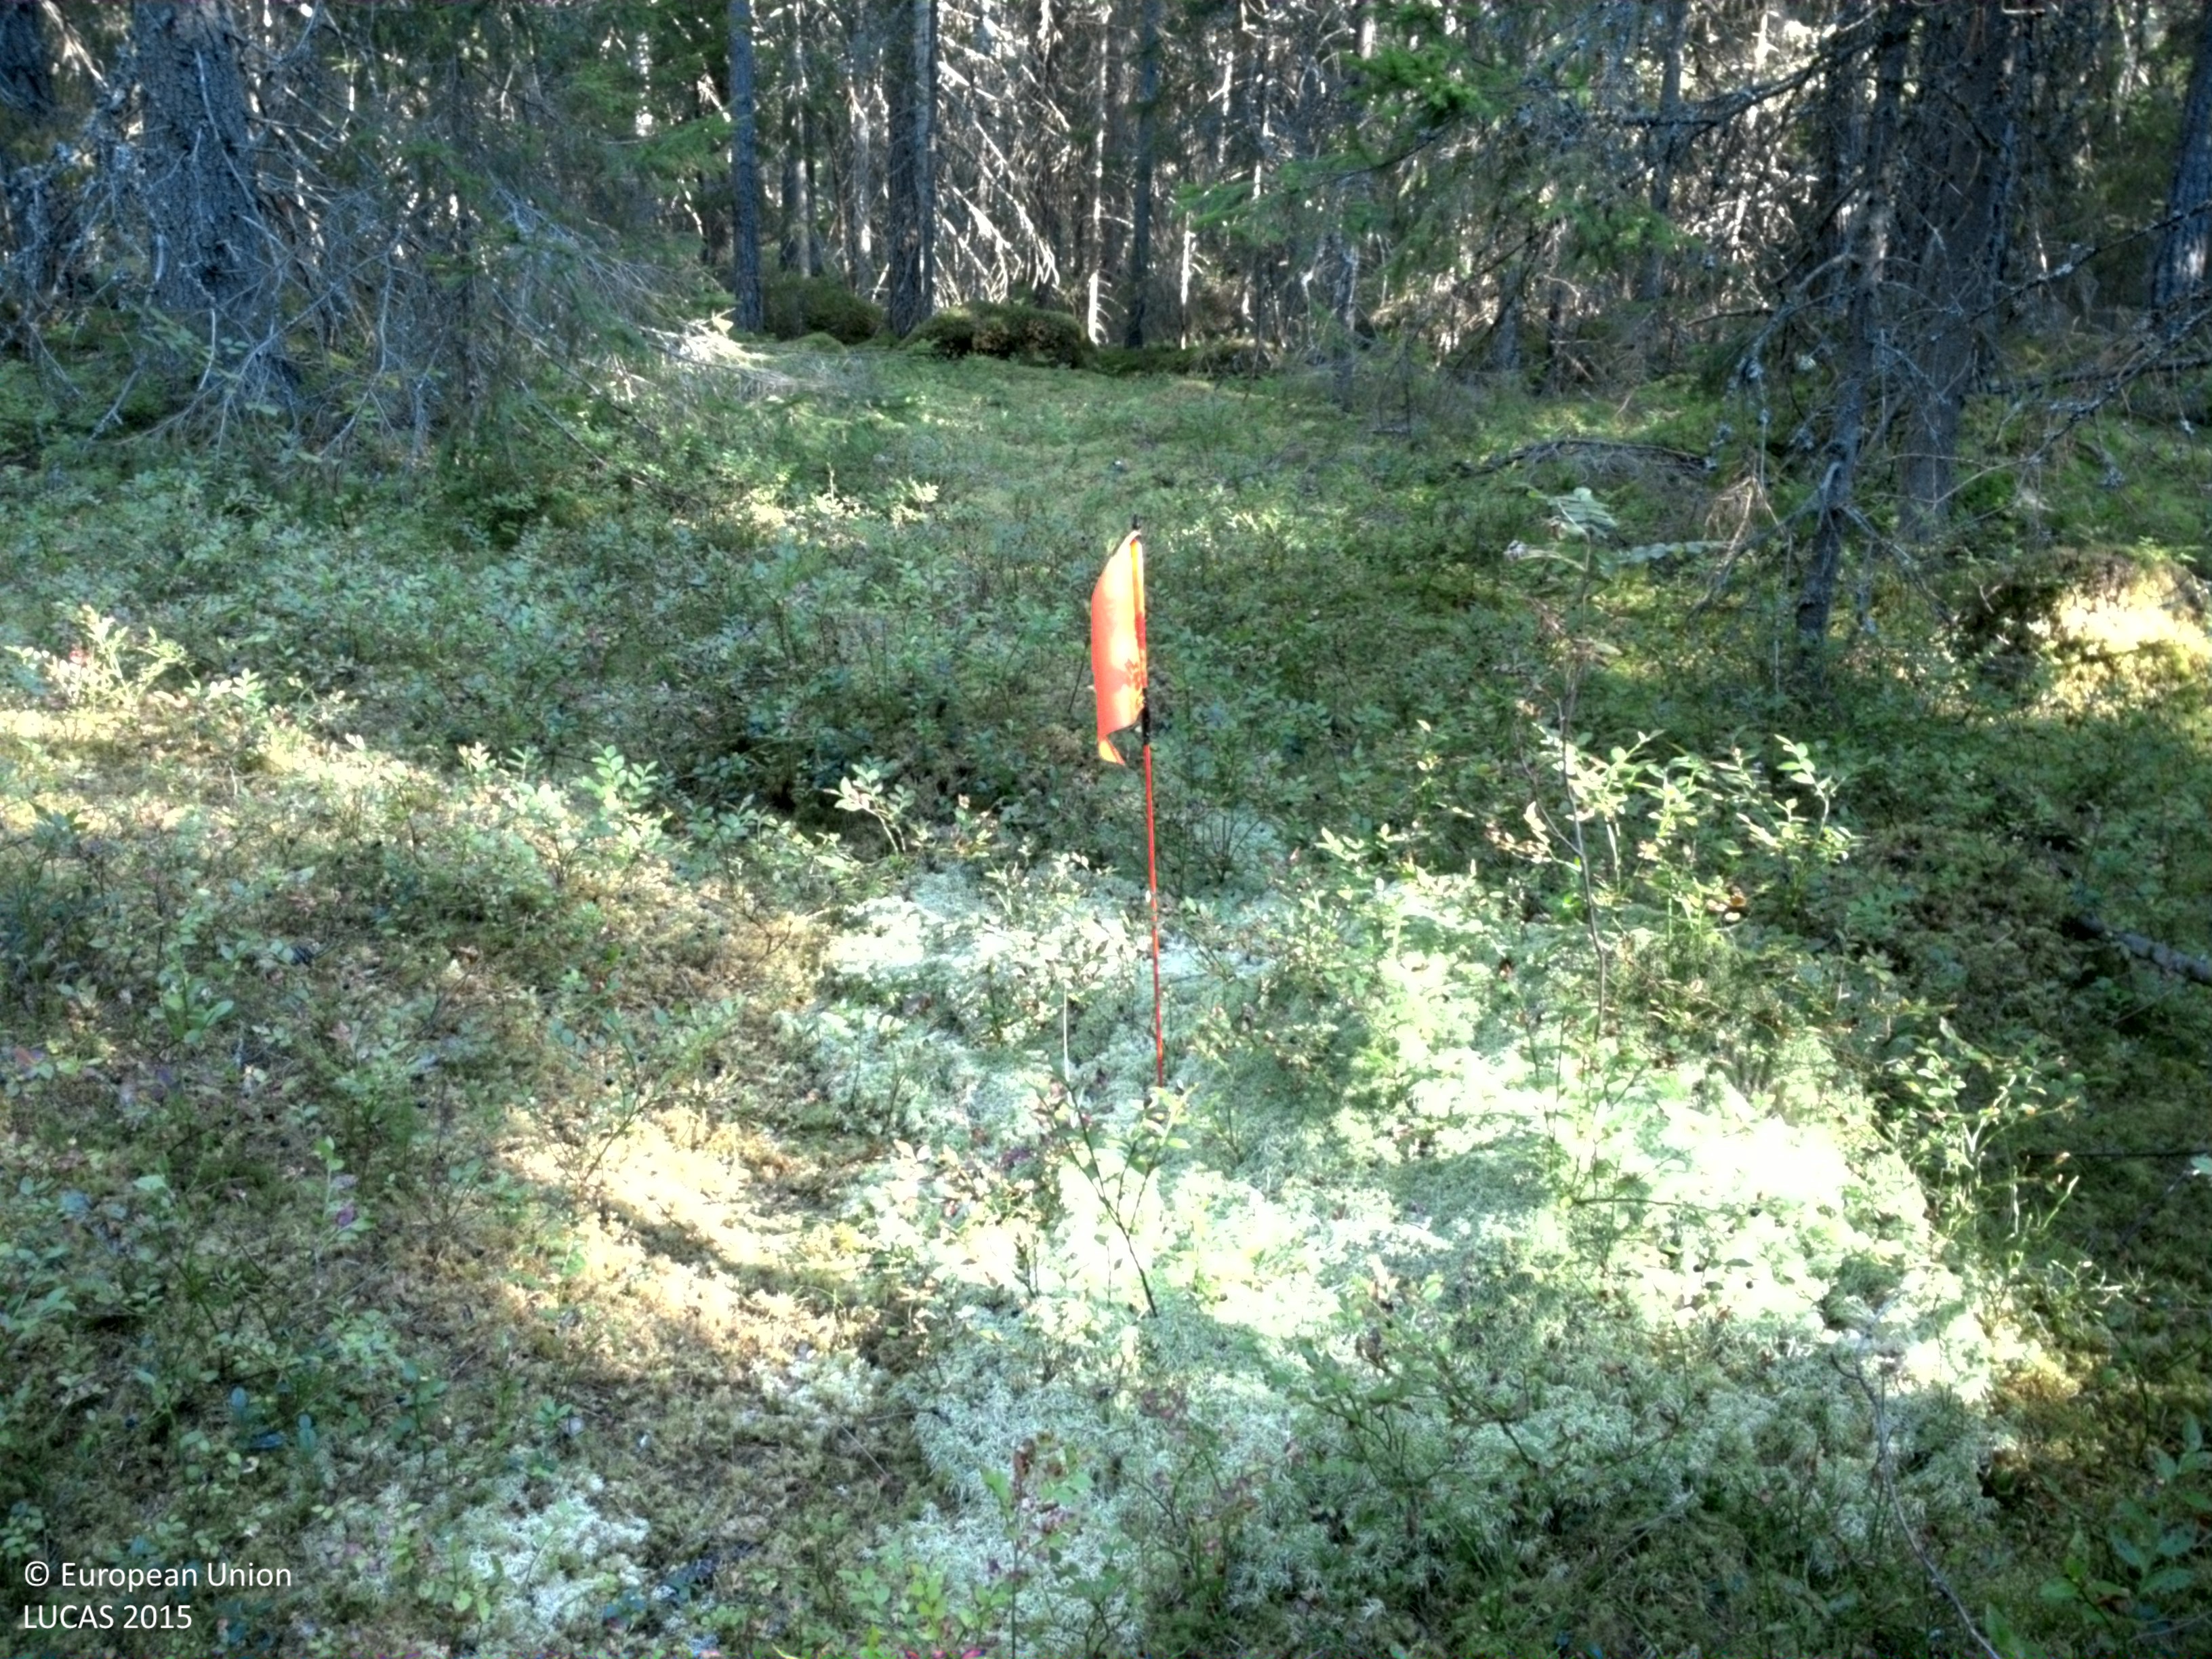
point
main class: Woodland
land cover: Spruce dominated coniferous woodland
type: boreal forest
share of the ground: > 75 %
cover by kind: coniferous forest trees 70 %, lichens and mosses 25 %, broadleaved forest trees 5 %
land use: Amenities, museums, leisure
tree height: > 5 m
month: August
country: SE
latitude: 59.8322
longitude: 17.5762
